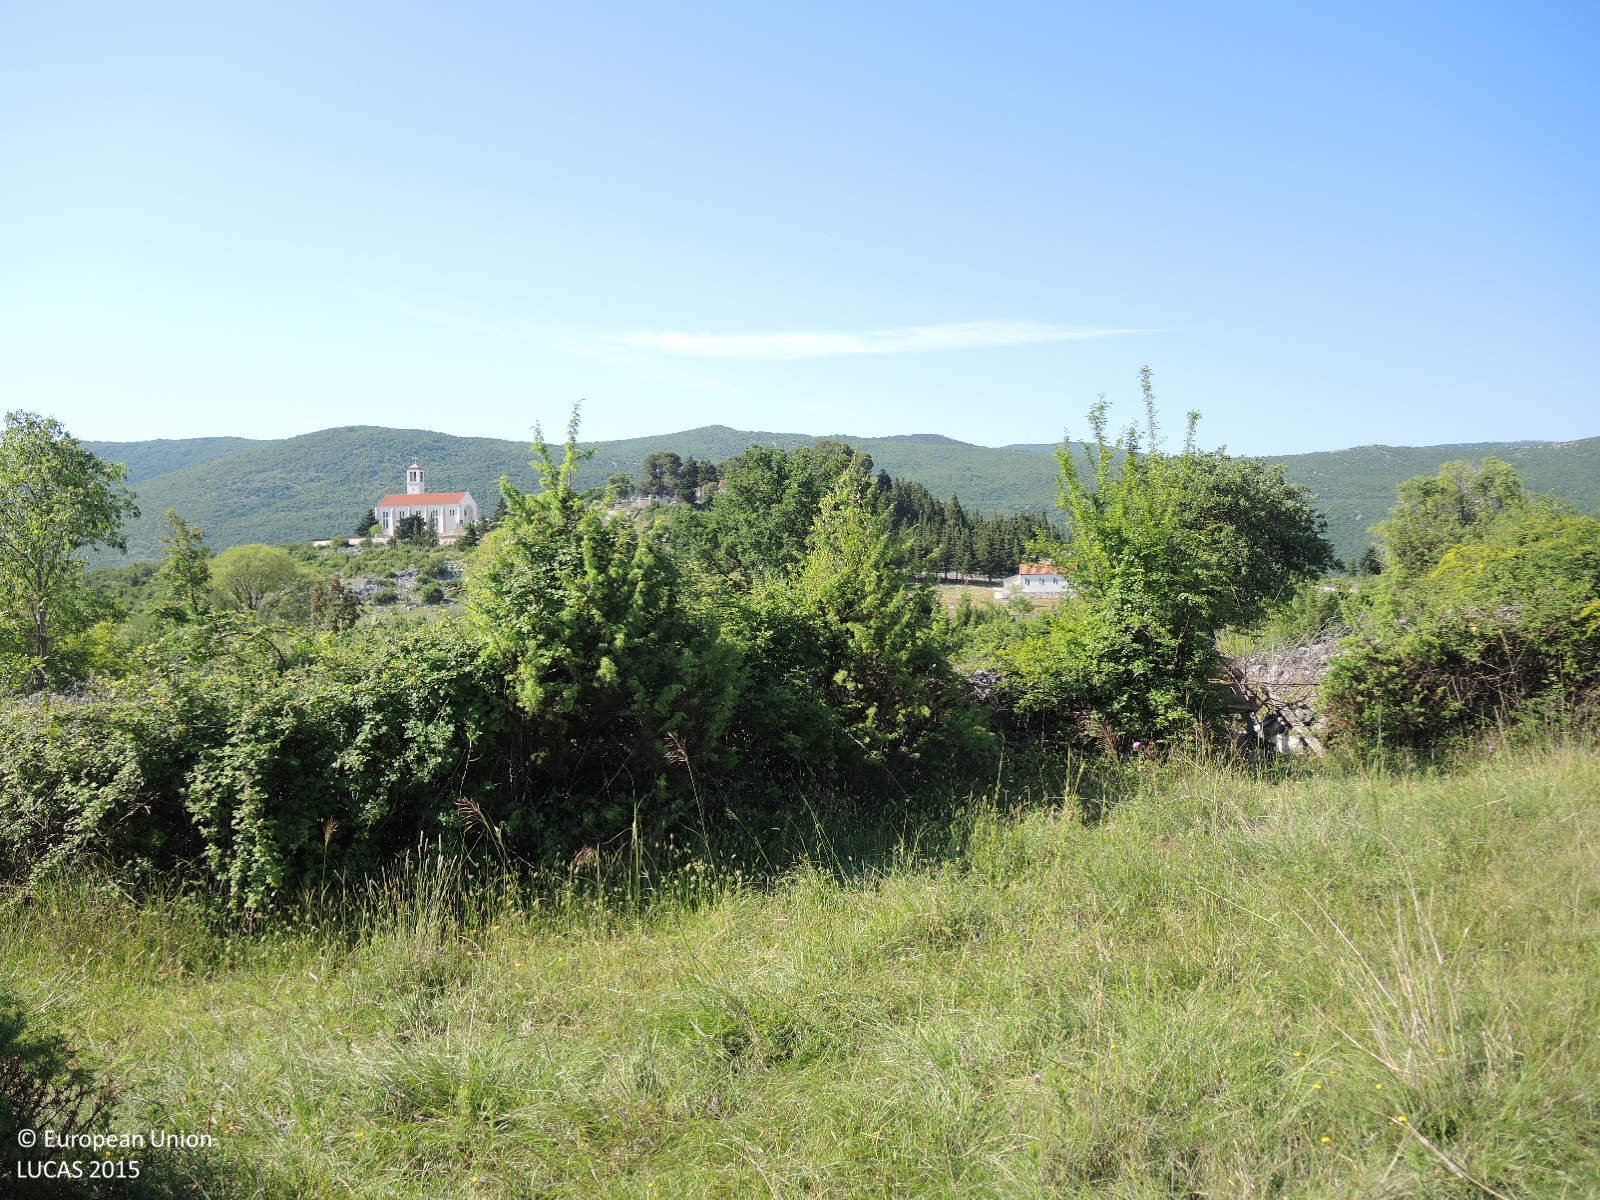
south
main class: Shrubland
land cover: Shrubland with sparse tree cover
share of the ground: 25 - 50 %
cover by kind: herbaceous plants 45 %, shrubs 40 %, broadleaved forest trees 5 %, consolidated bare surface 5 %, unconsolidated bare surface 5 %
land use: Semi-natural and natural areas not in use
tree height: < 5 m
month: June
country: HR
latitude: 43.6419
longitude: 16.1769
